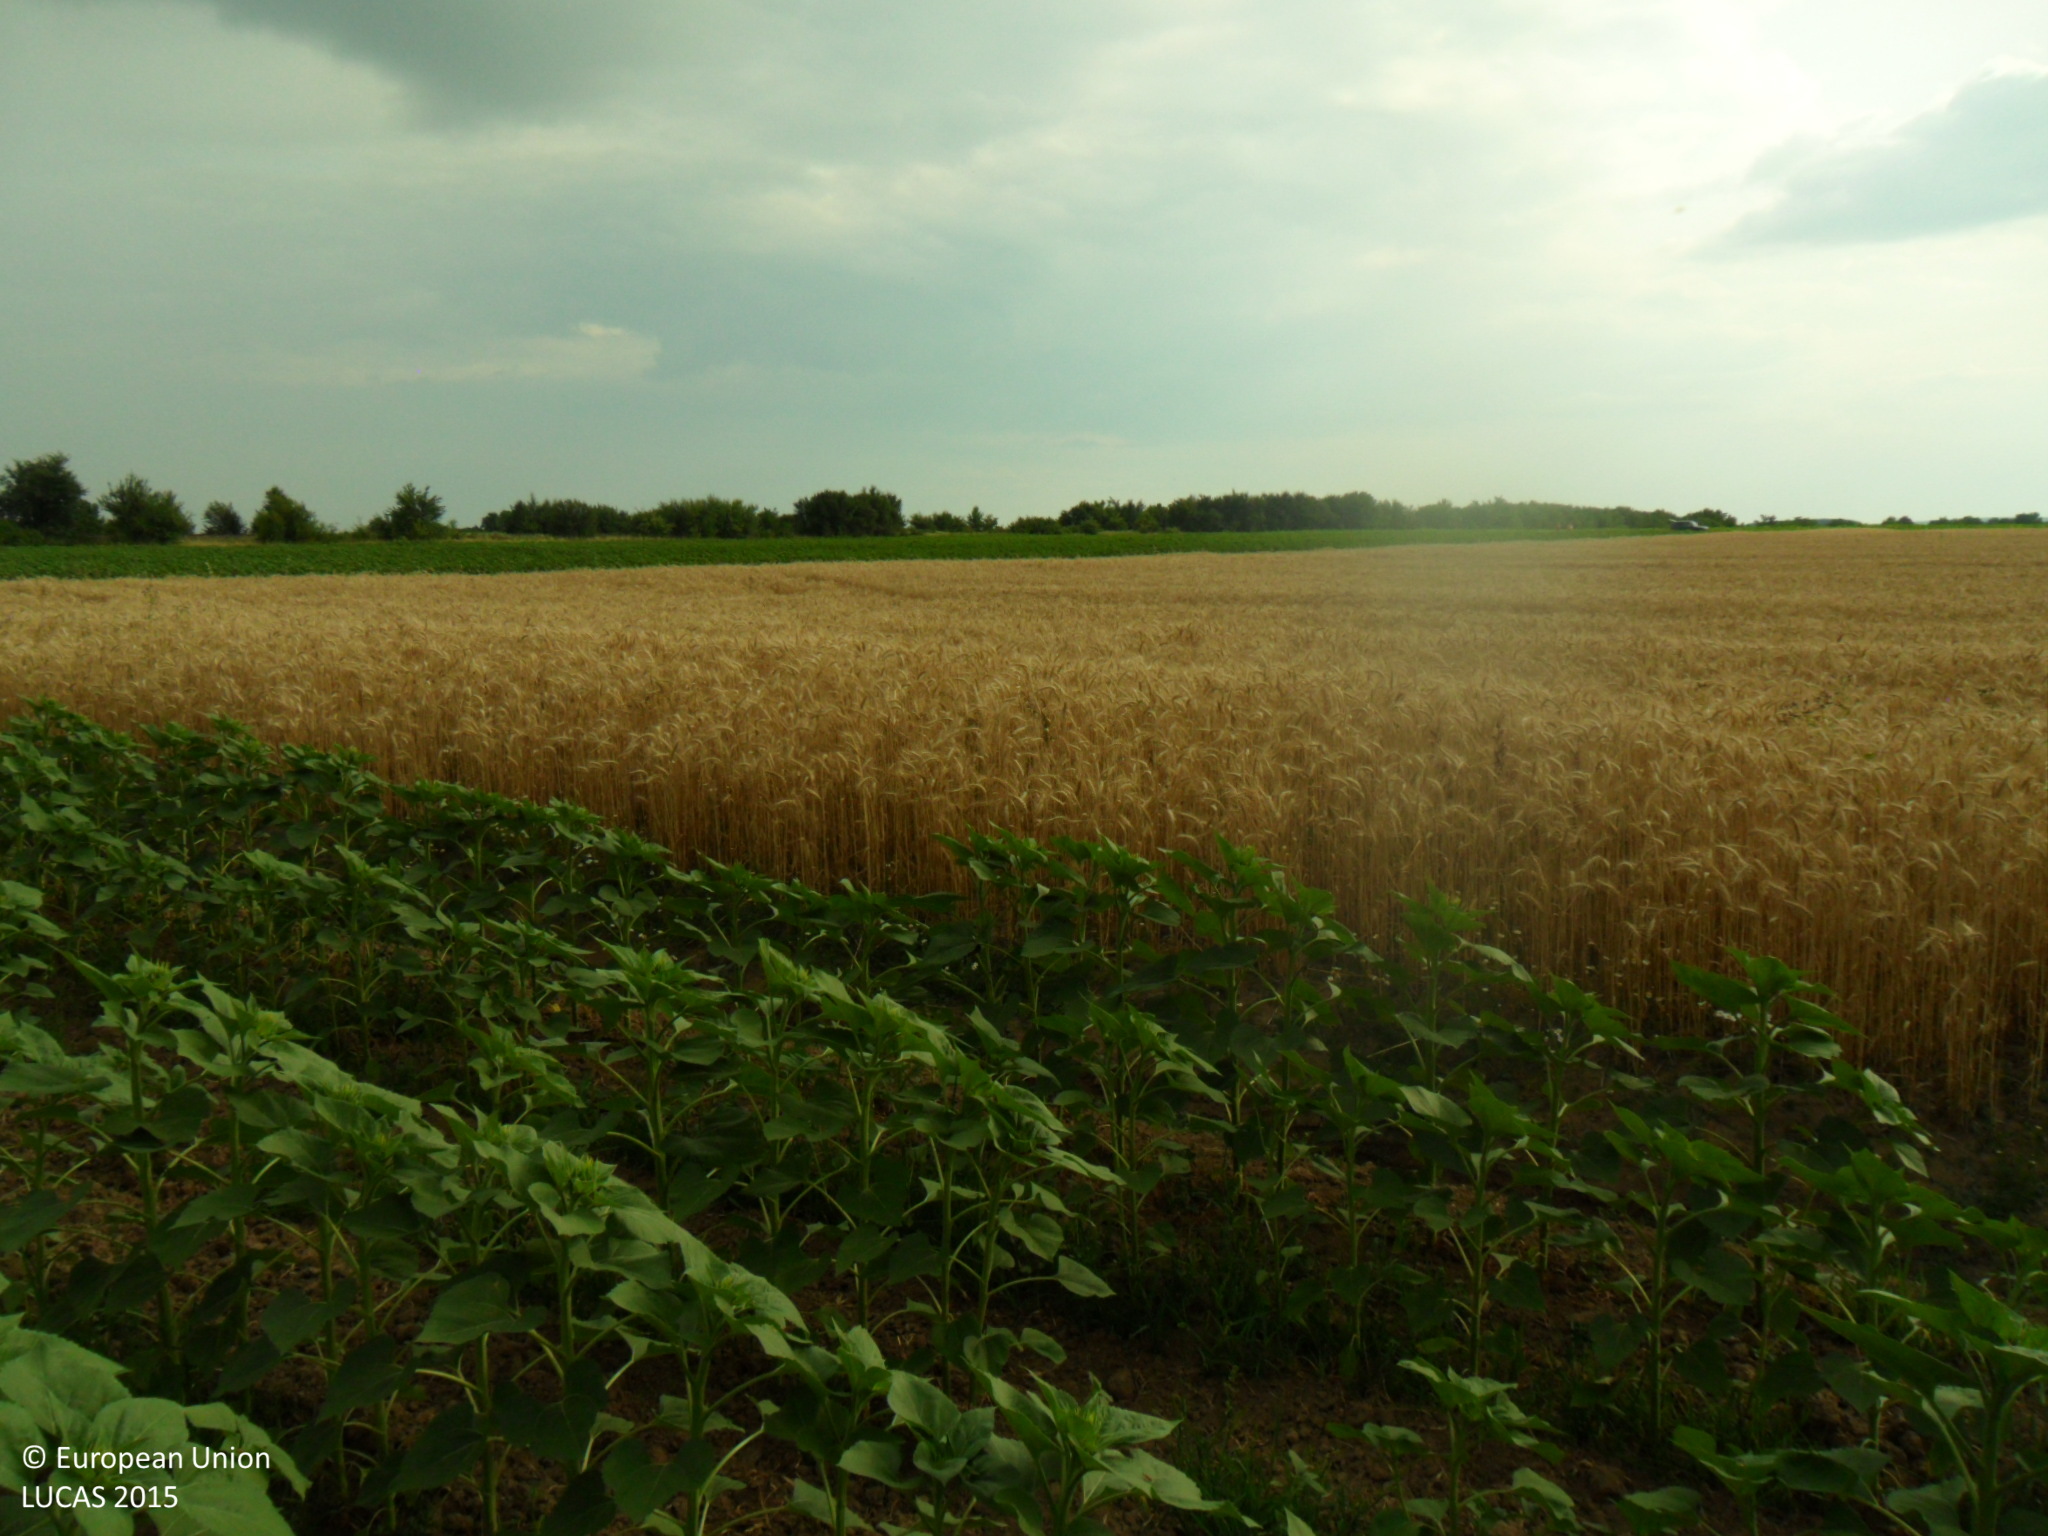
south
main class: Cropland
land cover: Sunflower
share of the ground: > 75 %
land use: Agriculture (excluding fallow land and kitchen gardens)
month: July
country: BG
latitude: 43.5730
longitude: 26.8174
